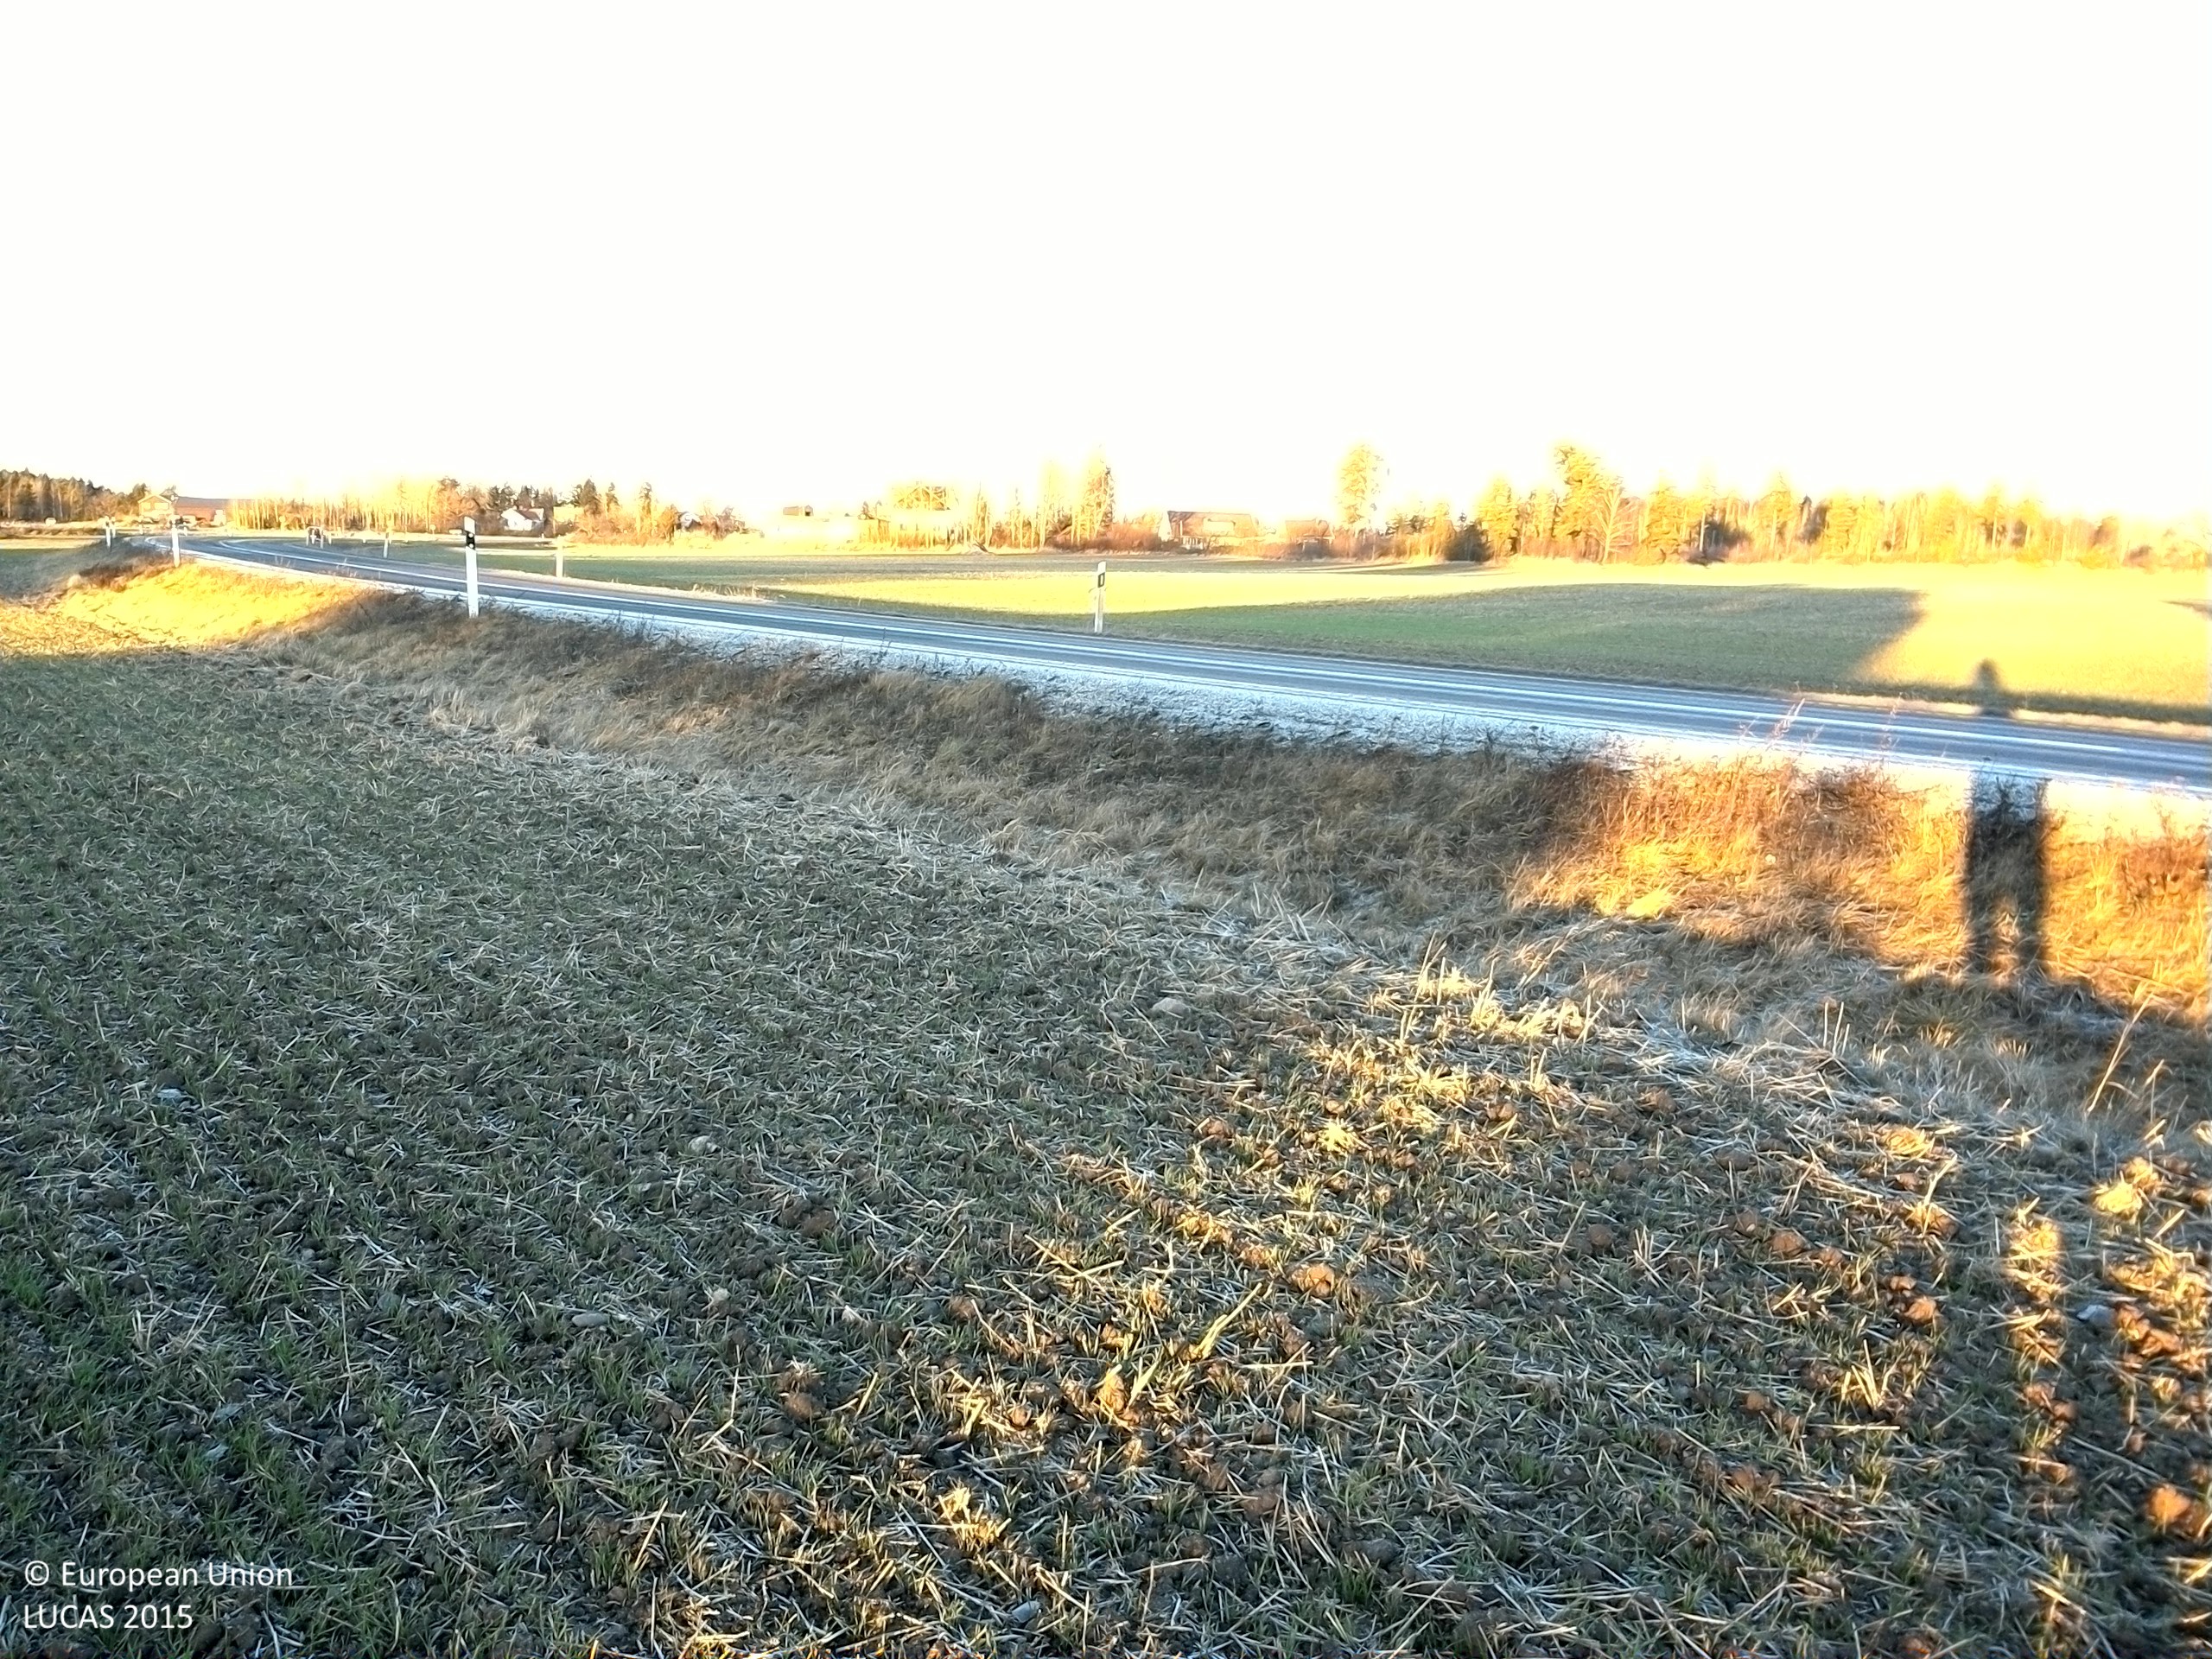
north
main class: Cropland
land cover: Common wheat
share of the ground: > 75 %
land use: Agriculture (excluding fallow land and kitchen gardens)
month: December
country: SE
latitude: 59.2882
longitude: 16.5412
